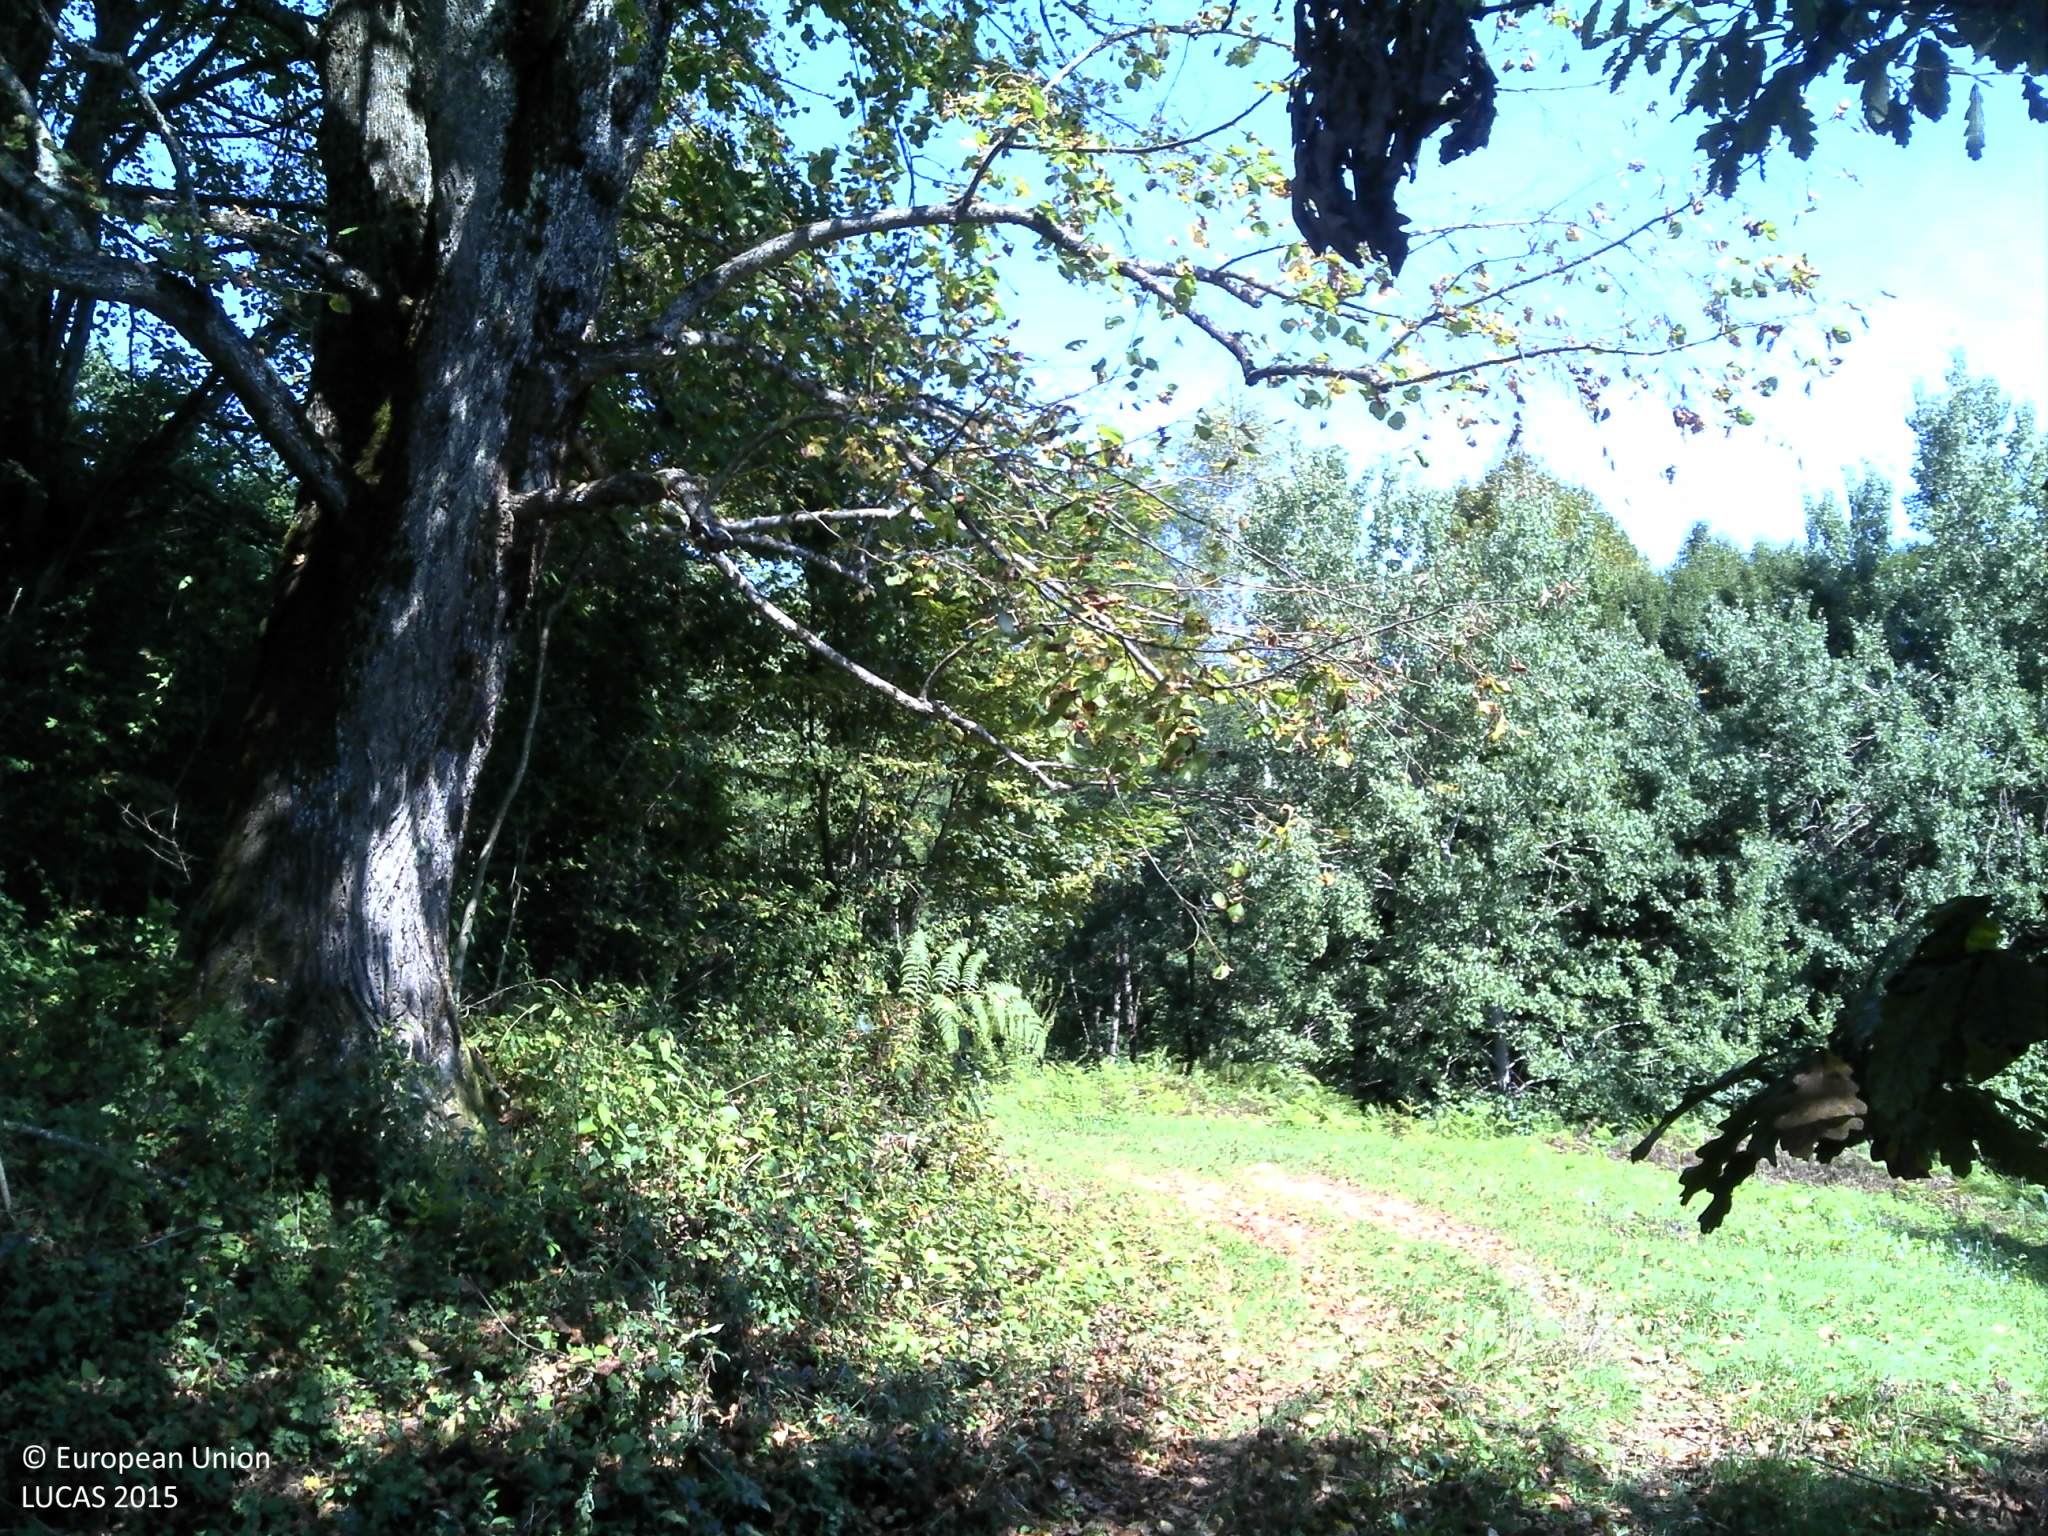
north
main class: Woodland
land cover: Broadleaved woodland
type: acidophilous oak and oak-birch forest
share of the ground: > 75 %
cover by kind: broadleaved forest trees 95 %, shrubs 5 %
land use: Semi-natural and natural areas not in use
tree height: > 5 m
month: August
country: HR
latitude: 45.0849
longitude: 15.5979
